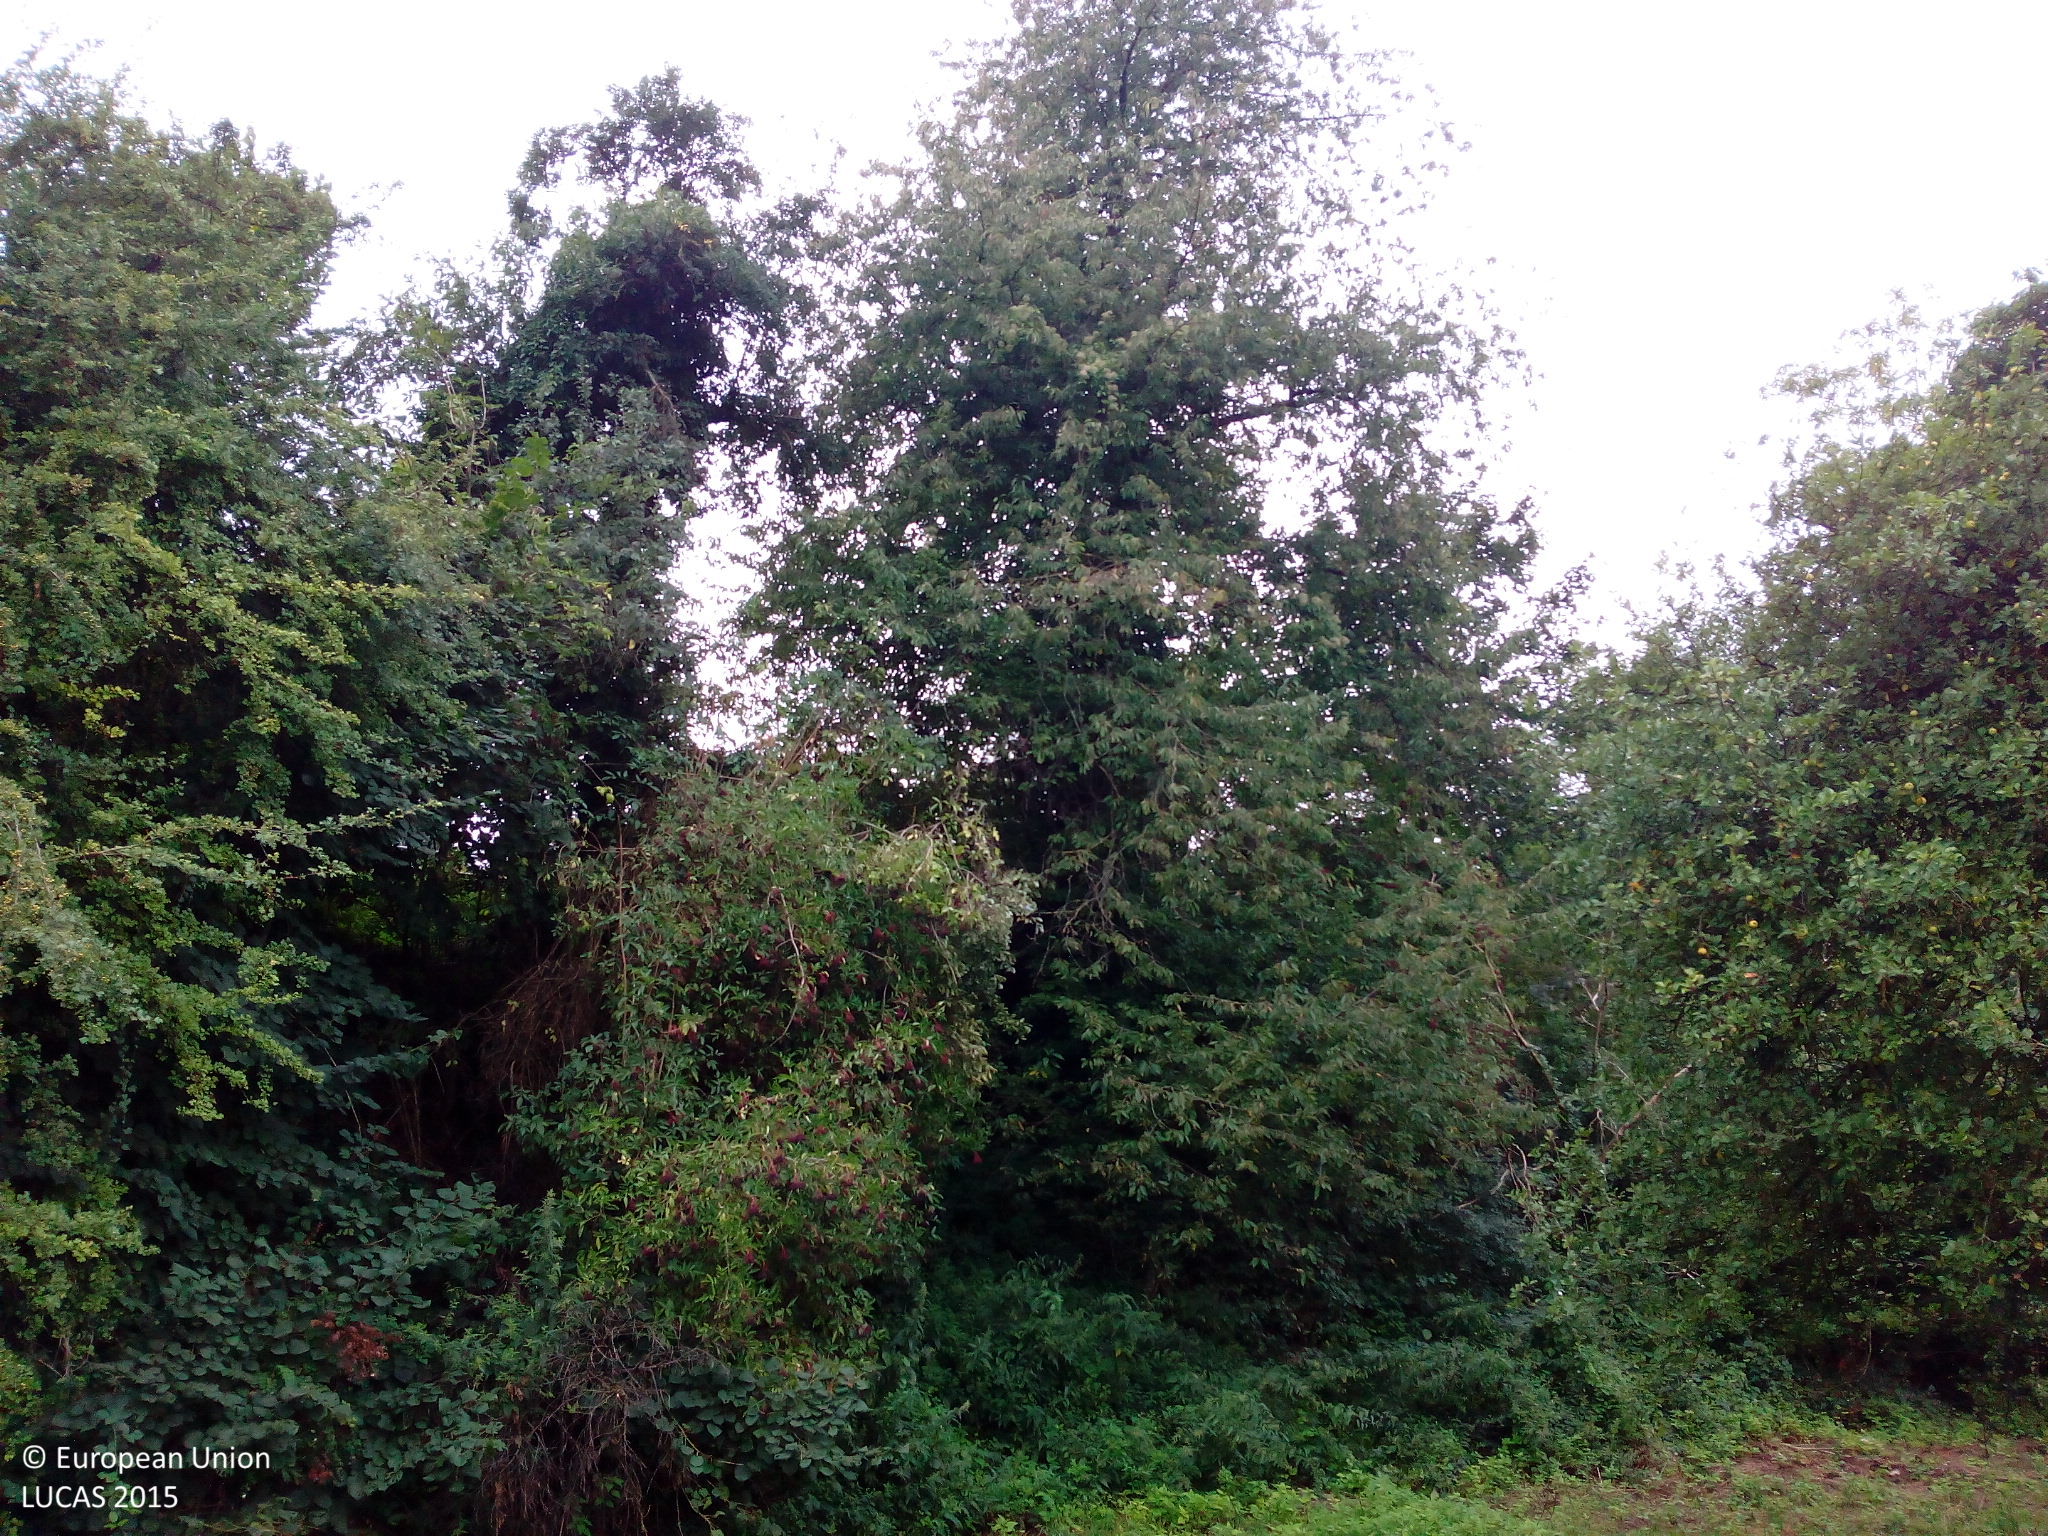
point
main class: Woodland
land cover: Broadleaved woodland
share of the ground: 50 - 75 %
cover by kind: broadleaved forest trees 70 %, herbaceous plants 15 %, shrubs 10 %, unconsolidated bare surface 5 %
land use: Semi-natural and natural areas not in use
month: August
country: DE
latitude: 49.1146
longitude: 8.6168
